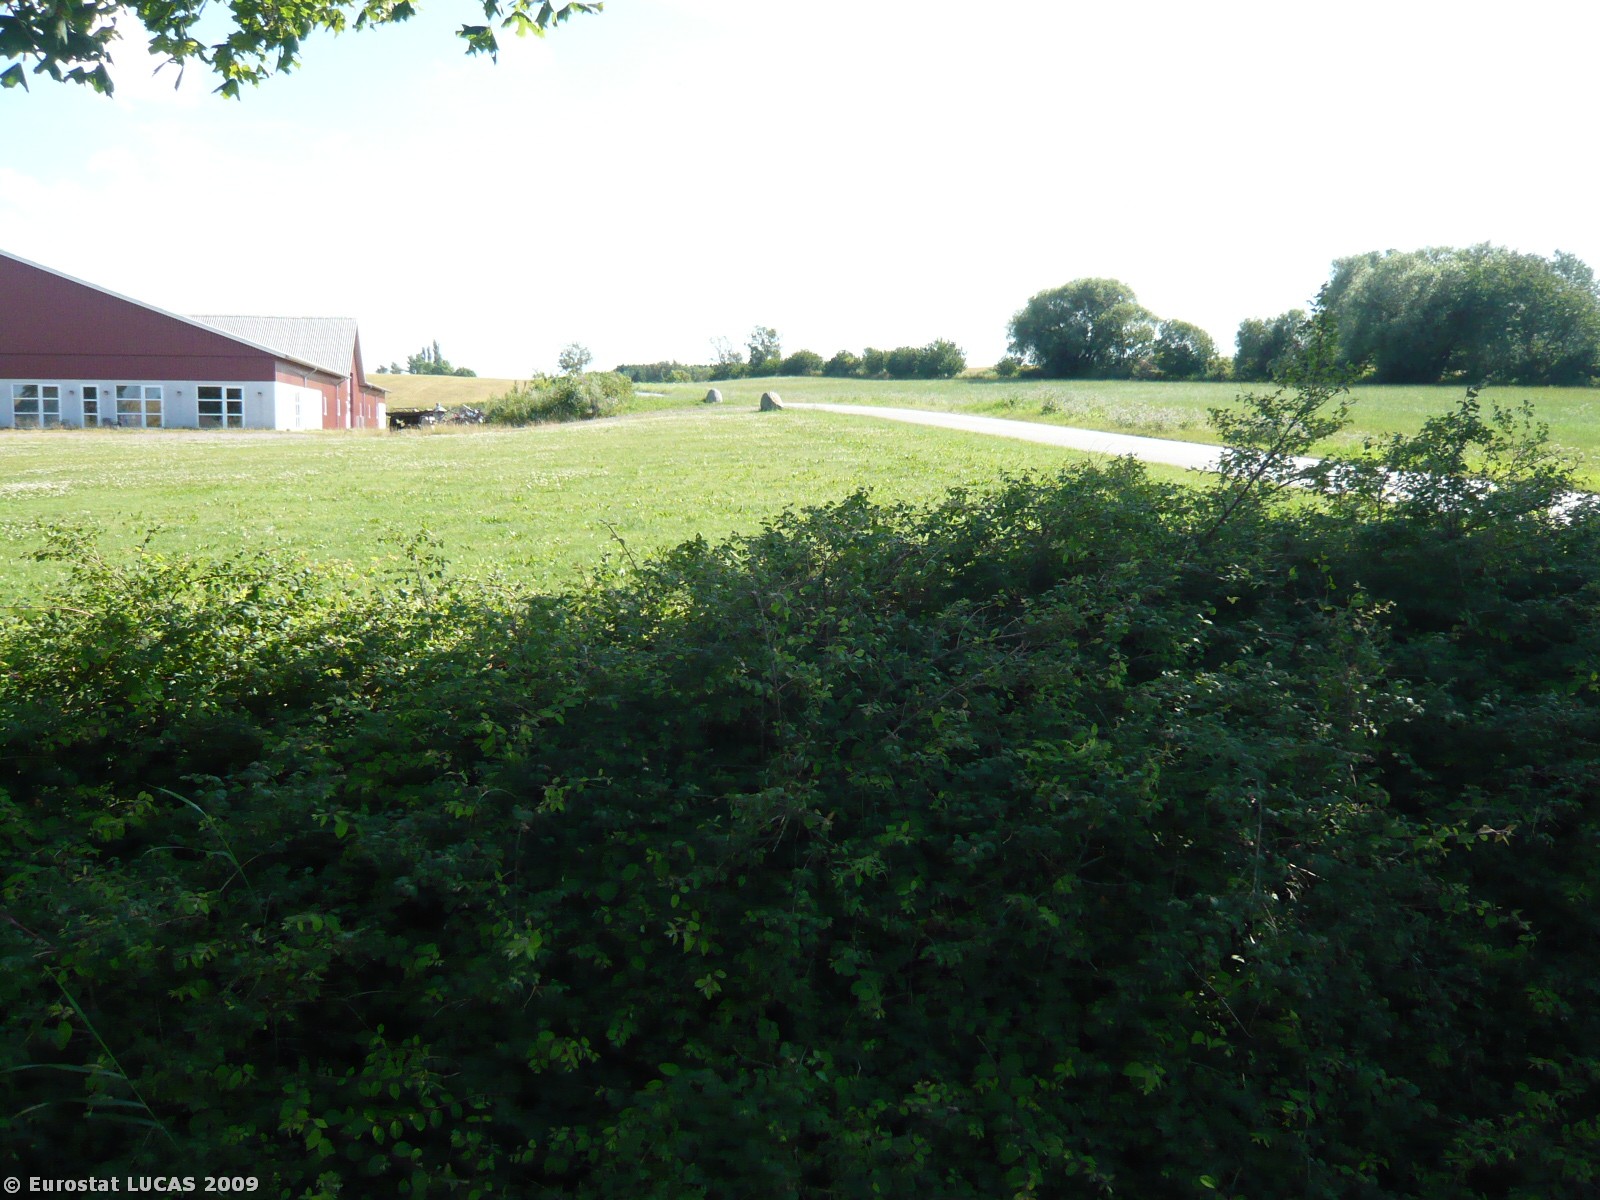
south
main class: Cropland
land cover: Common wheat
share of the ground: > 75 %
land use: Agriculture (excluding fallow land and kitchen gardens)
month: July
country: DK
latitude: 55.7634
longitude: 11.6718
